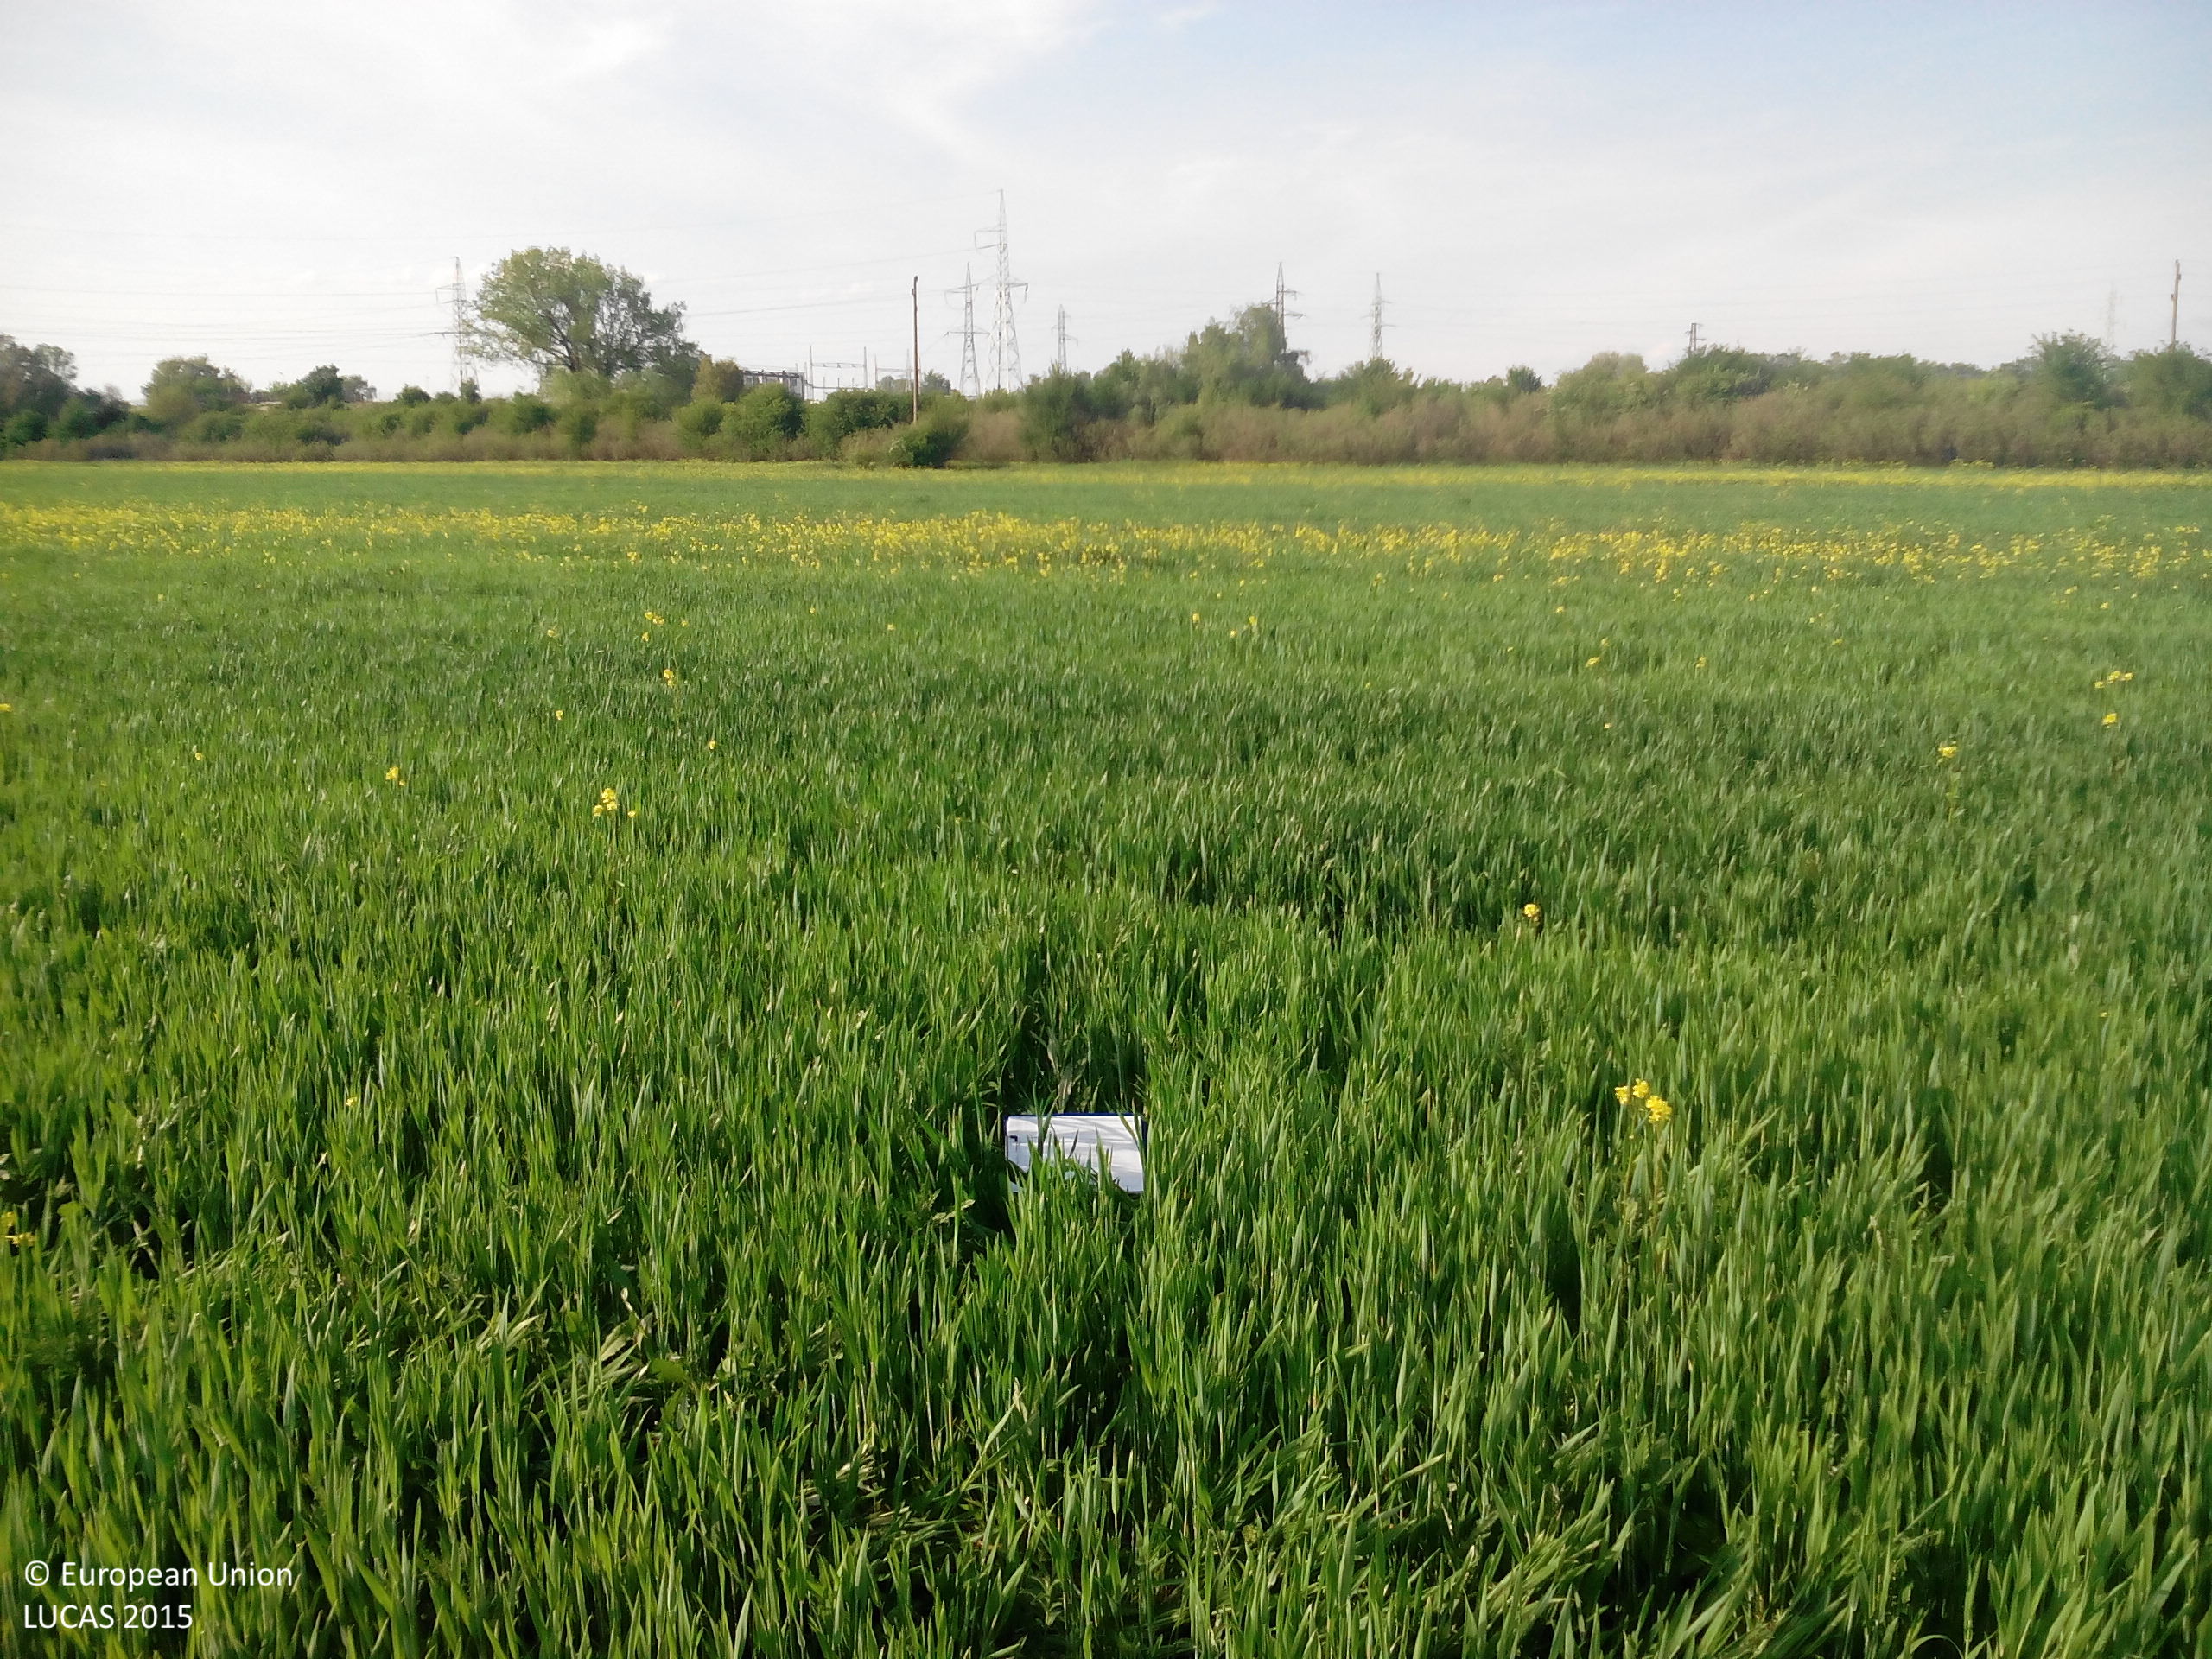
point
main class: Cropland
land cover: Common wheat
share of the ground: > 75 %
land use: Agriculture (excluding fallow land and kitchen gardens)
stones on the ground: < 10 %
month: May
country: BG
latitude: 43.7458
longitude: 23.8489
